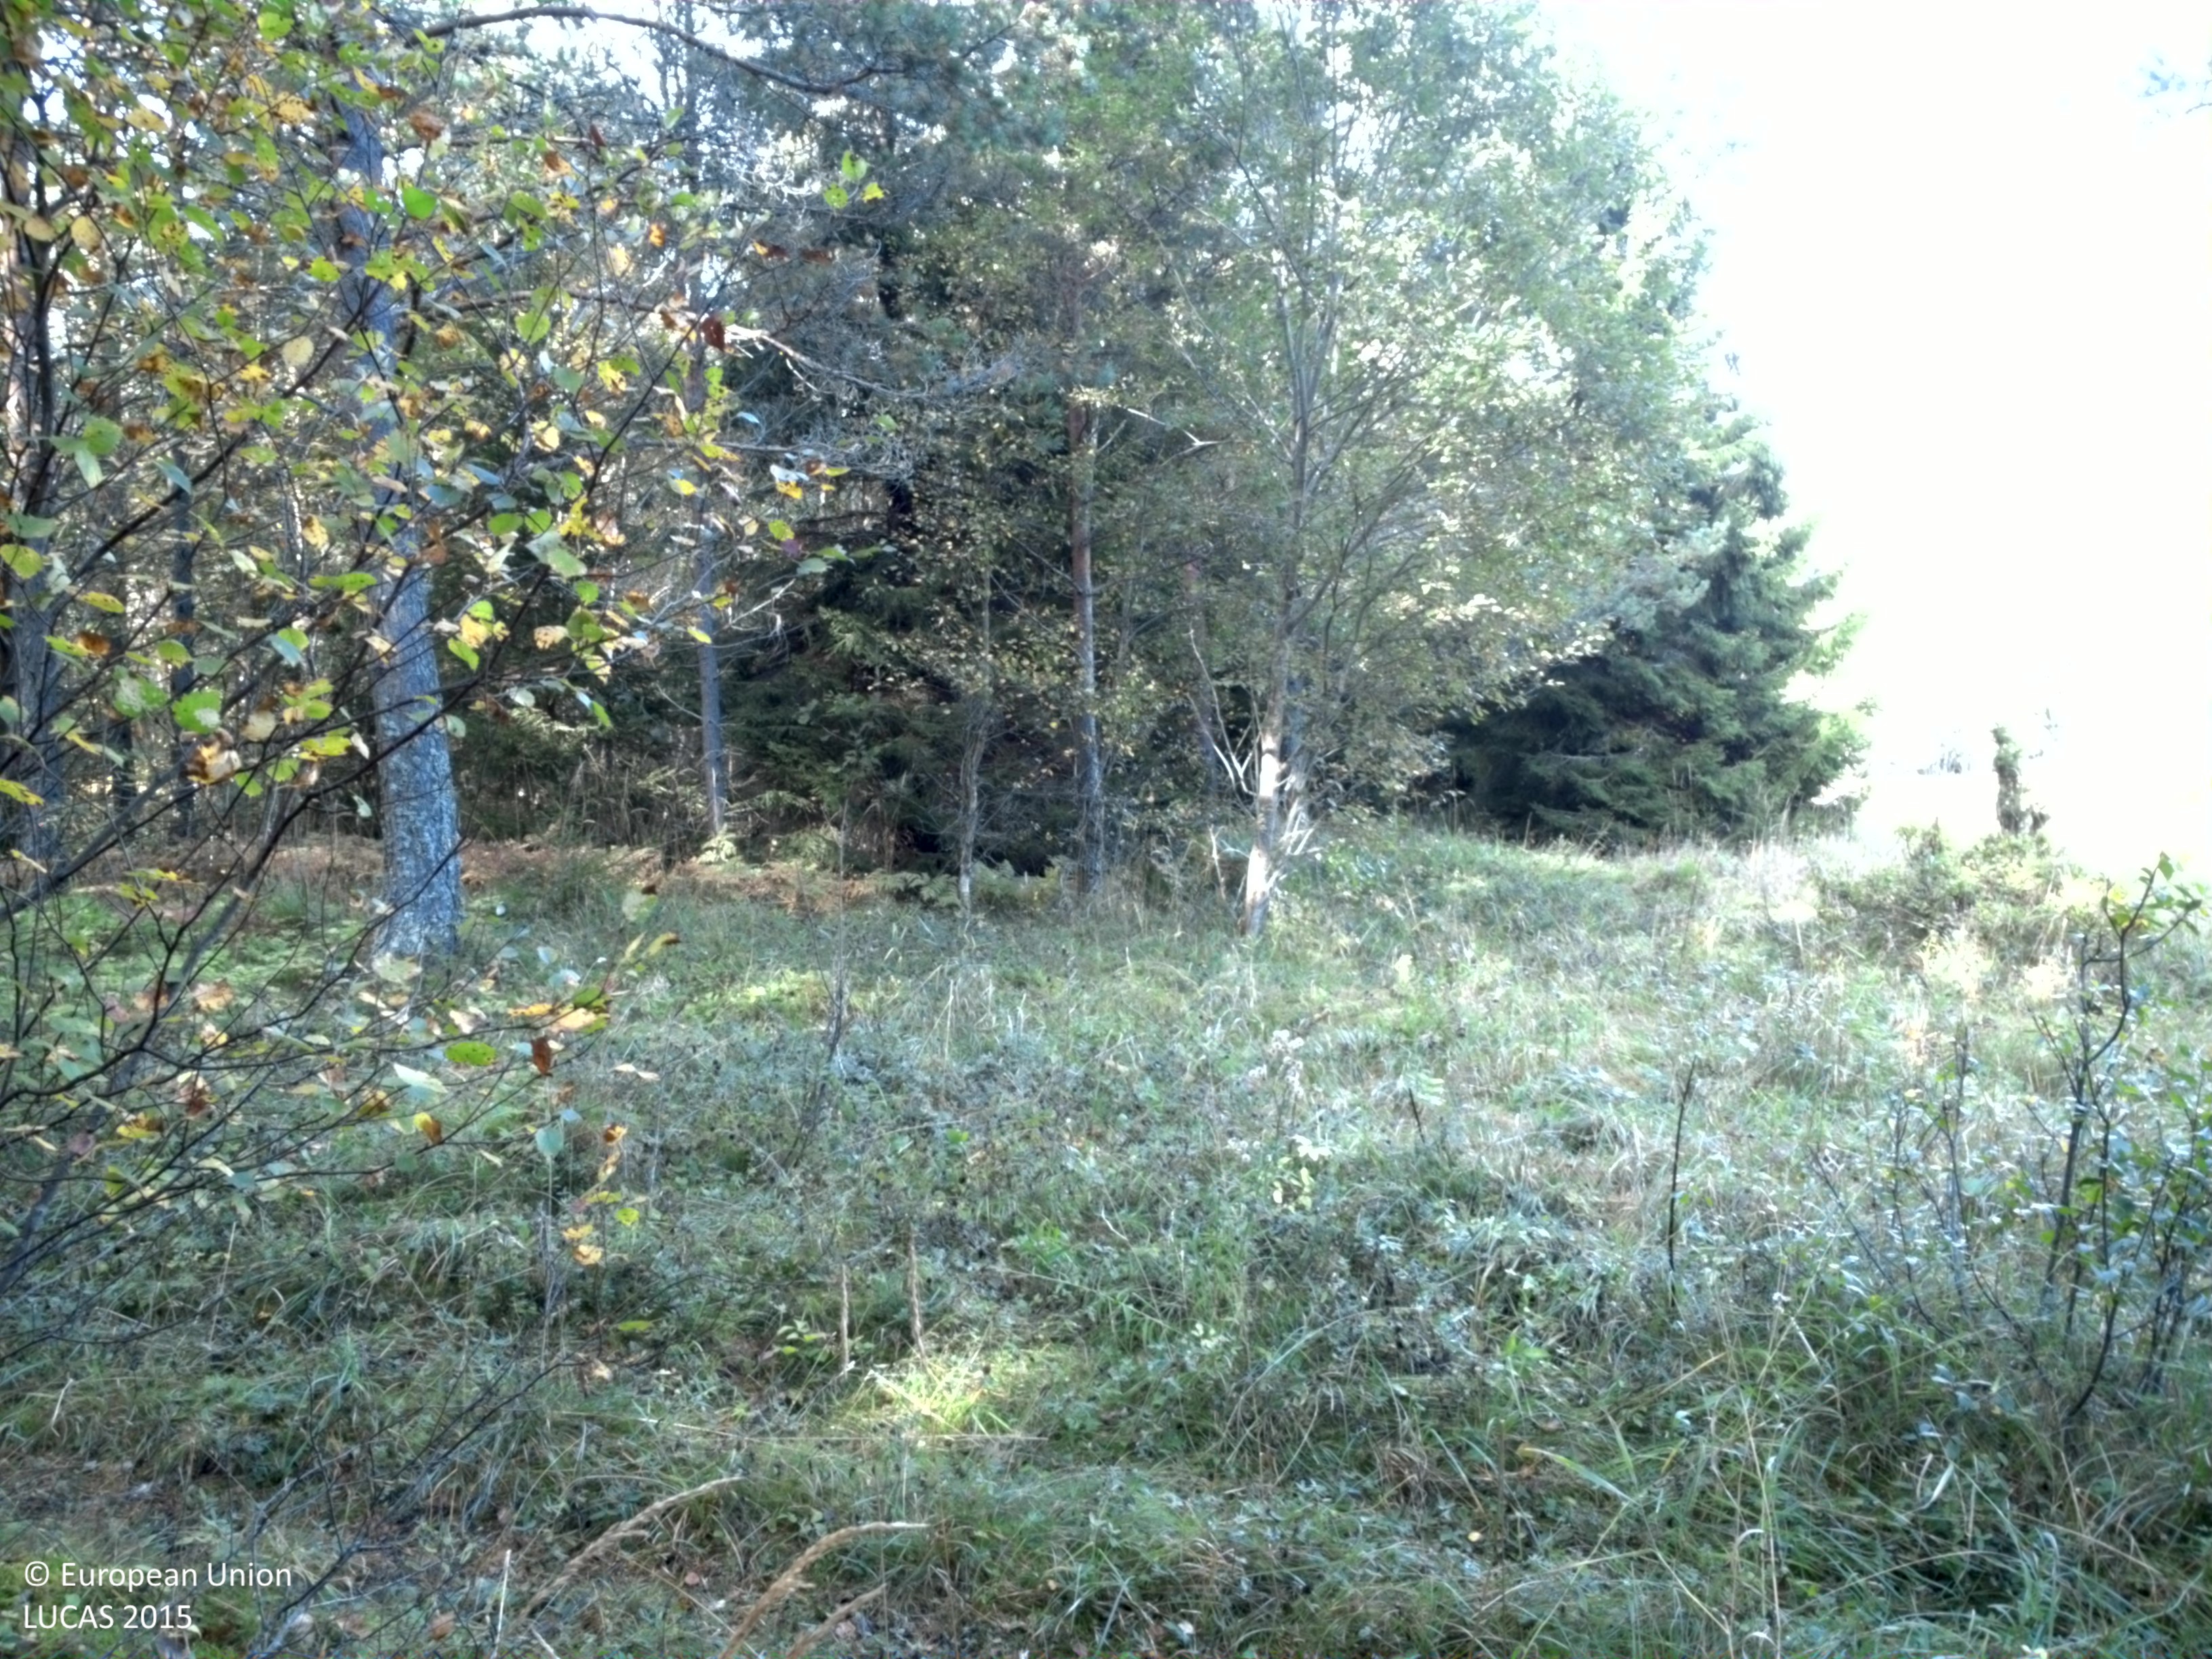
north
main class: Woodland
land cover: Pine dominated coniferous woodland
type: boreal forest
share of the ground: 50 - 75 %
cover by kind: coniferous forest trees 50 %, herbaceous plants 40 %, broadleaved forest trees 10 %
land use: Forestry
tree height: > 5 m
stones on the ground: < 10 %
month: September
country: SE
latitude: 59.8465
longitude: 18.8708
